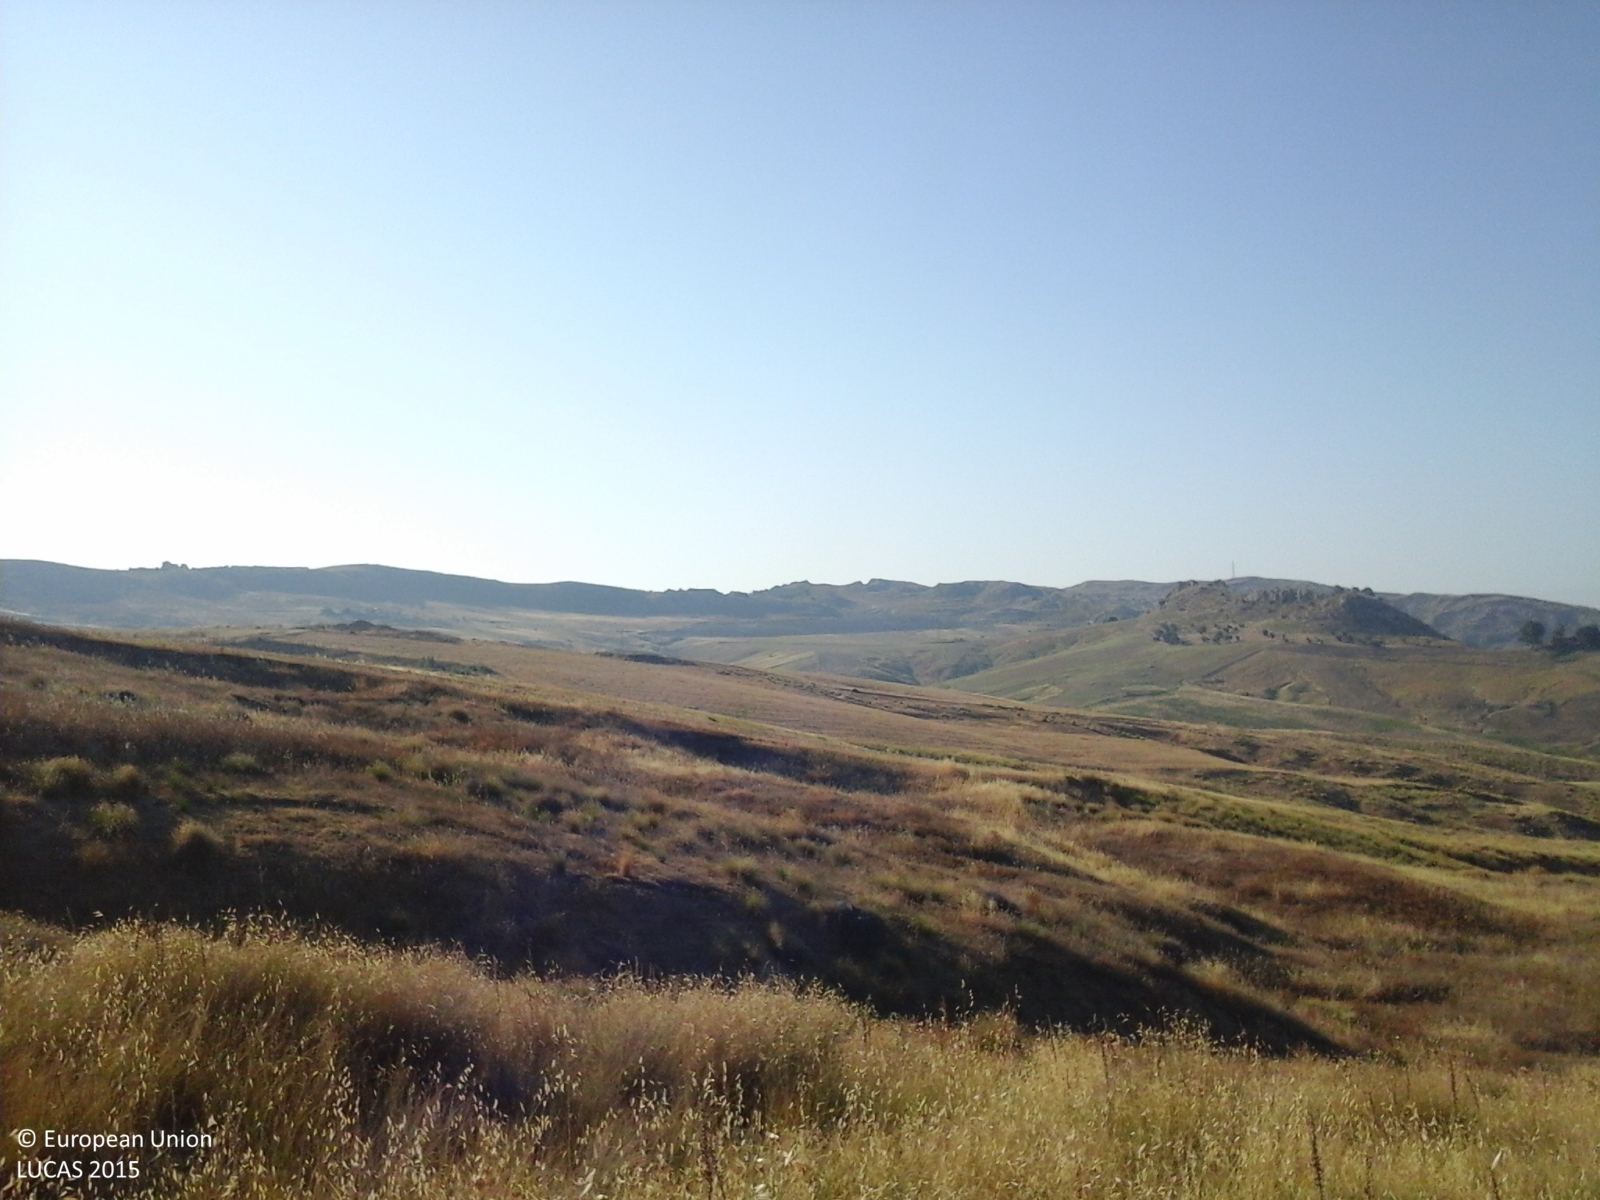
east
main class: Grassland
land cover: Grassland without tree/shrub cover
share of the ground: > 75 %
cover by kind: herbaceous plants 100 %
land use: Semi-natural and natural areas not in use
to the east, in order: Grassland without tree/shrub cover; Rivers and streams; Grassland without tree/shrub cover
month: July
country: IT
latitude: 37.1442
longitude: 14.2338
